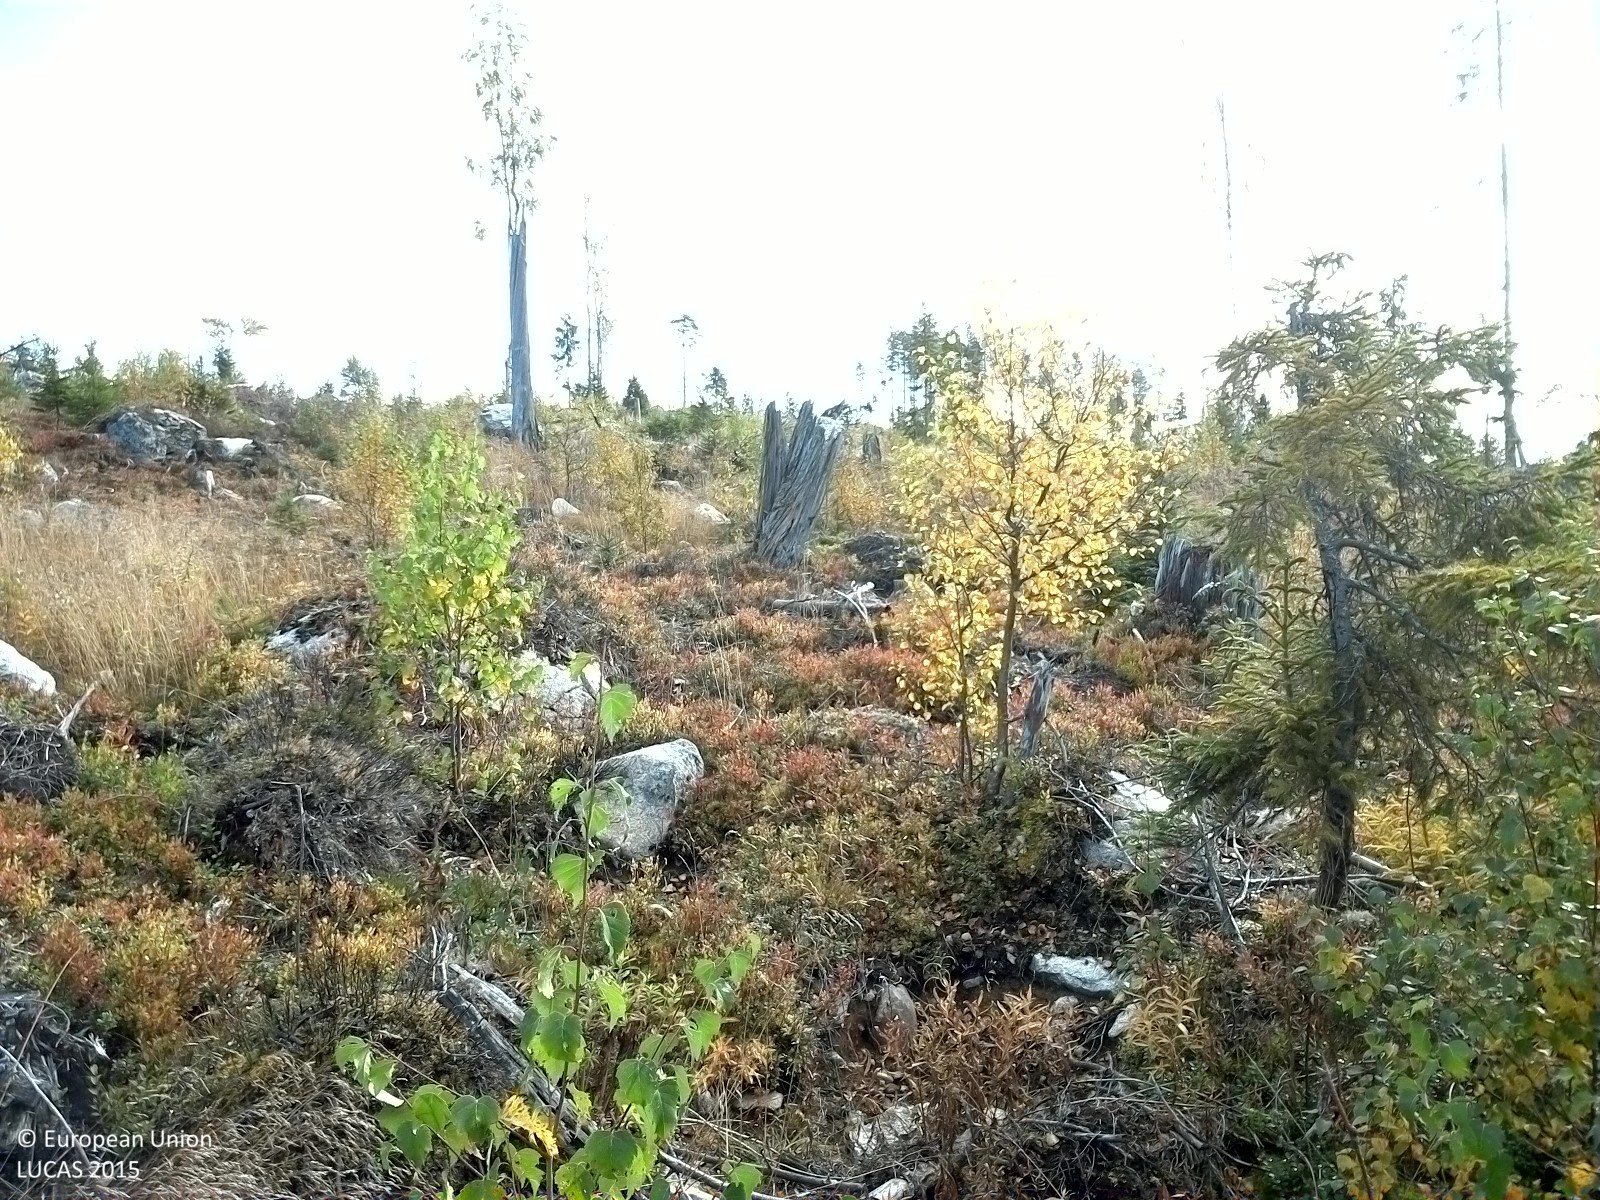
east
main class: Woodland
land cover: Spruce dominated mixed woodland
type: boreal forest
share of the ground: 10 - 25 %
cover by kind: shrubs 40 %, lichens and mosses 30 %, herbaceous plants 10 %, unconsolidated bare surface 10 %, coniferous forest trees 5 %, broadleaved forest trees 5 %
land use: Forestry
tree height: < 5 m
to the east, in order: Spruce dominated mixed woodland; Broadleaved woodland; Shrubland with sparse tree cover
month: September
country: SE
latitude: 62.1989
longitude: 16.1116
